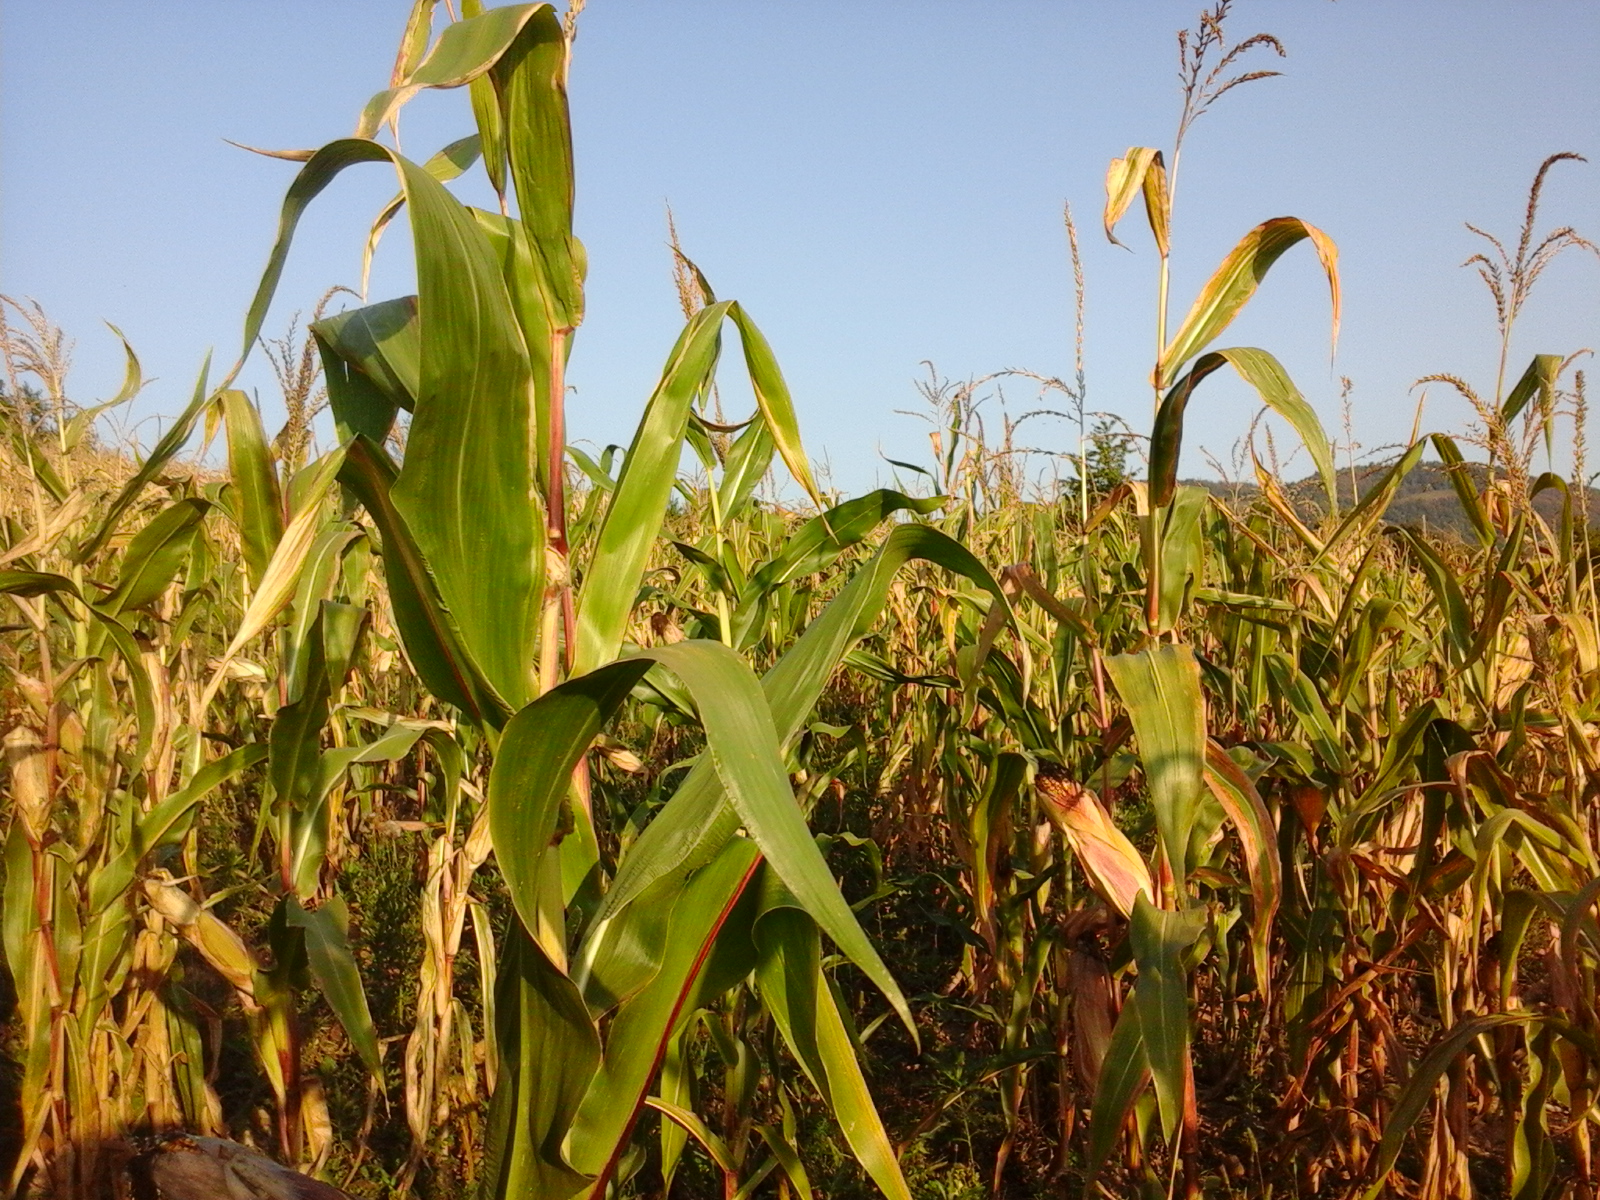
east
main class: Cropland
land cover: Maize
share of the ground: > 75 %
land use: Agriculture (excluding fallow land and kitchen gardens)
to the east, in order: Maize; Other fruit trees and berries; Grassland without tree/shrub cover; Tracks; Grassland without tree/shrub cover
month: September
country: RO
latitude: 46.5577
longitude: 22.5355
